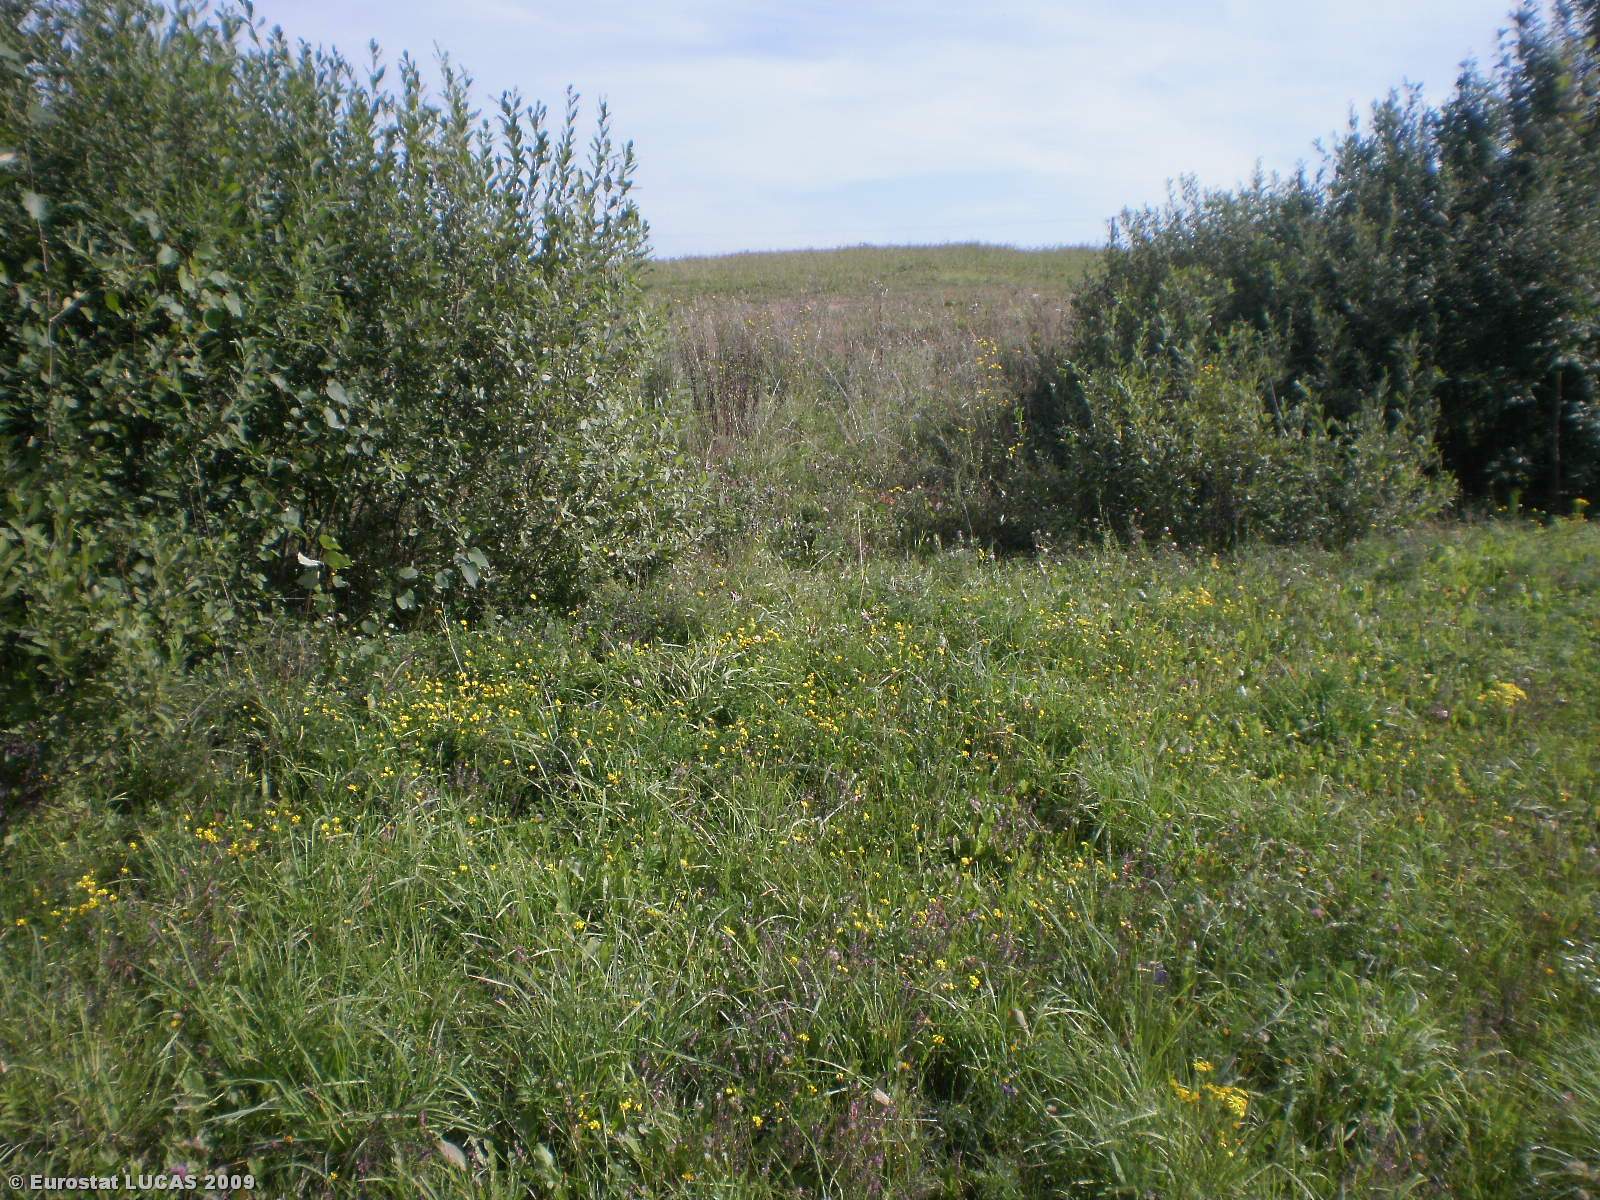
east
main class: Grassland
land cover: Grassland without tree/shrub cover
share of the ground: > 75 %
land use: Agriculture (excluding fallow land and kitchen gardens)
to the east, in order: Grassland without tree/shrub cover; Abandoned hedges; Grass margins; Paved roads, cycling and walking lanes; Grassland without tree/shrub cover; Electric lines; Grassland without tree/shrub cover; Common wheat
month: August
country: LT
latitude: 54.9288
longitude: 24.5697
